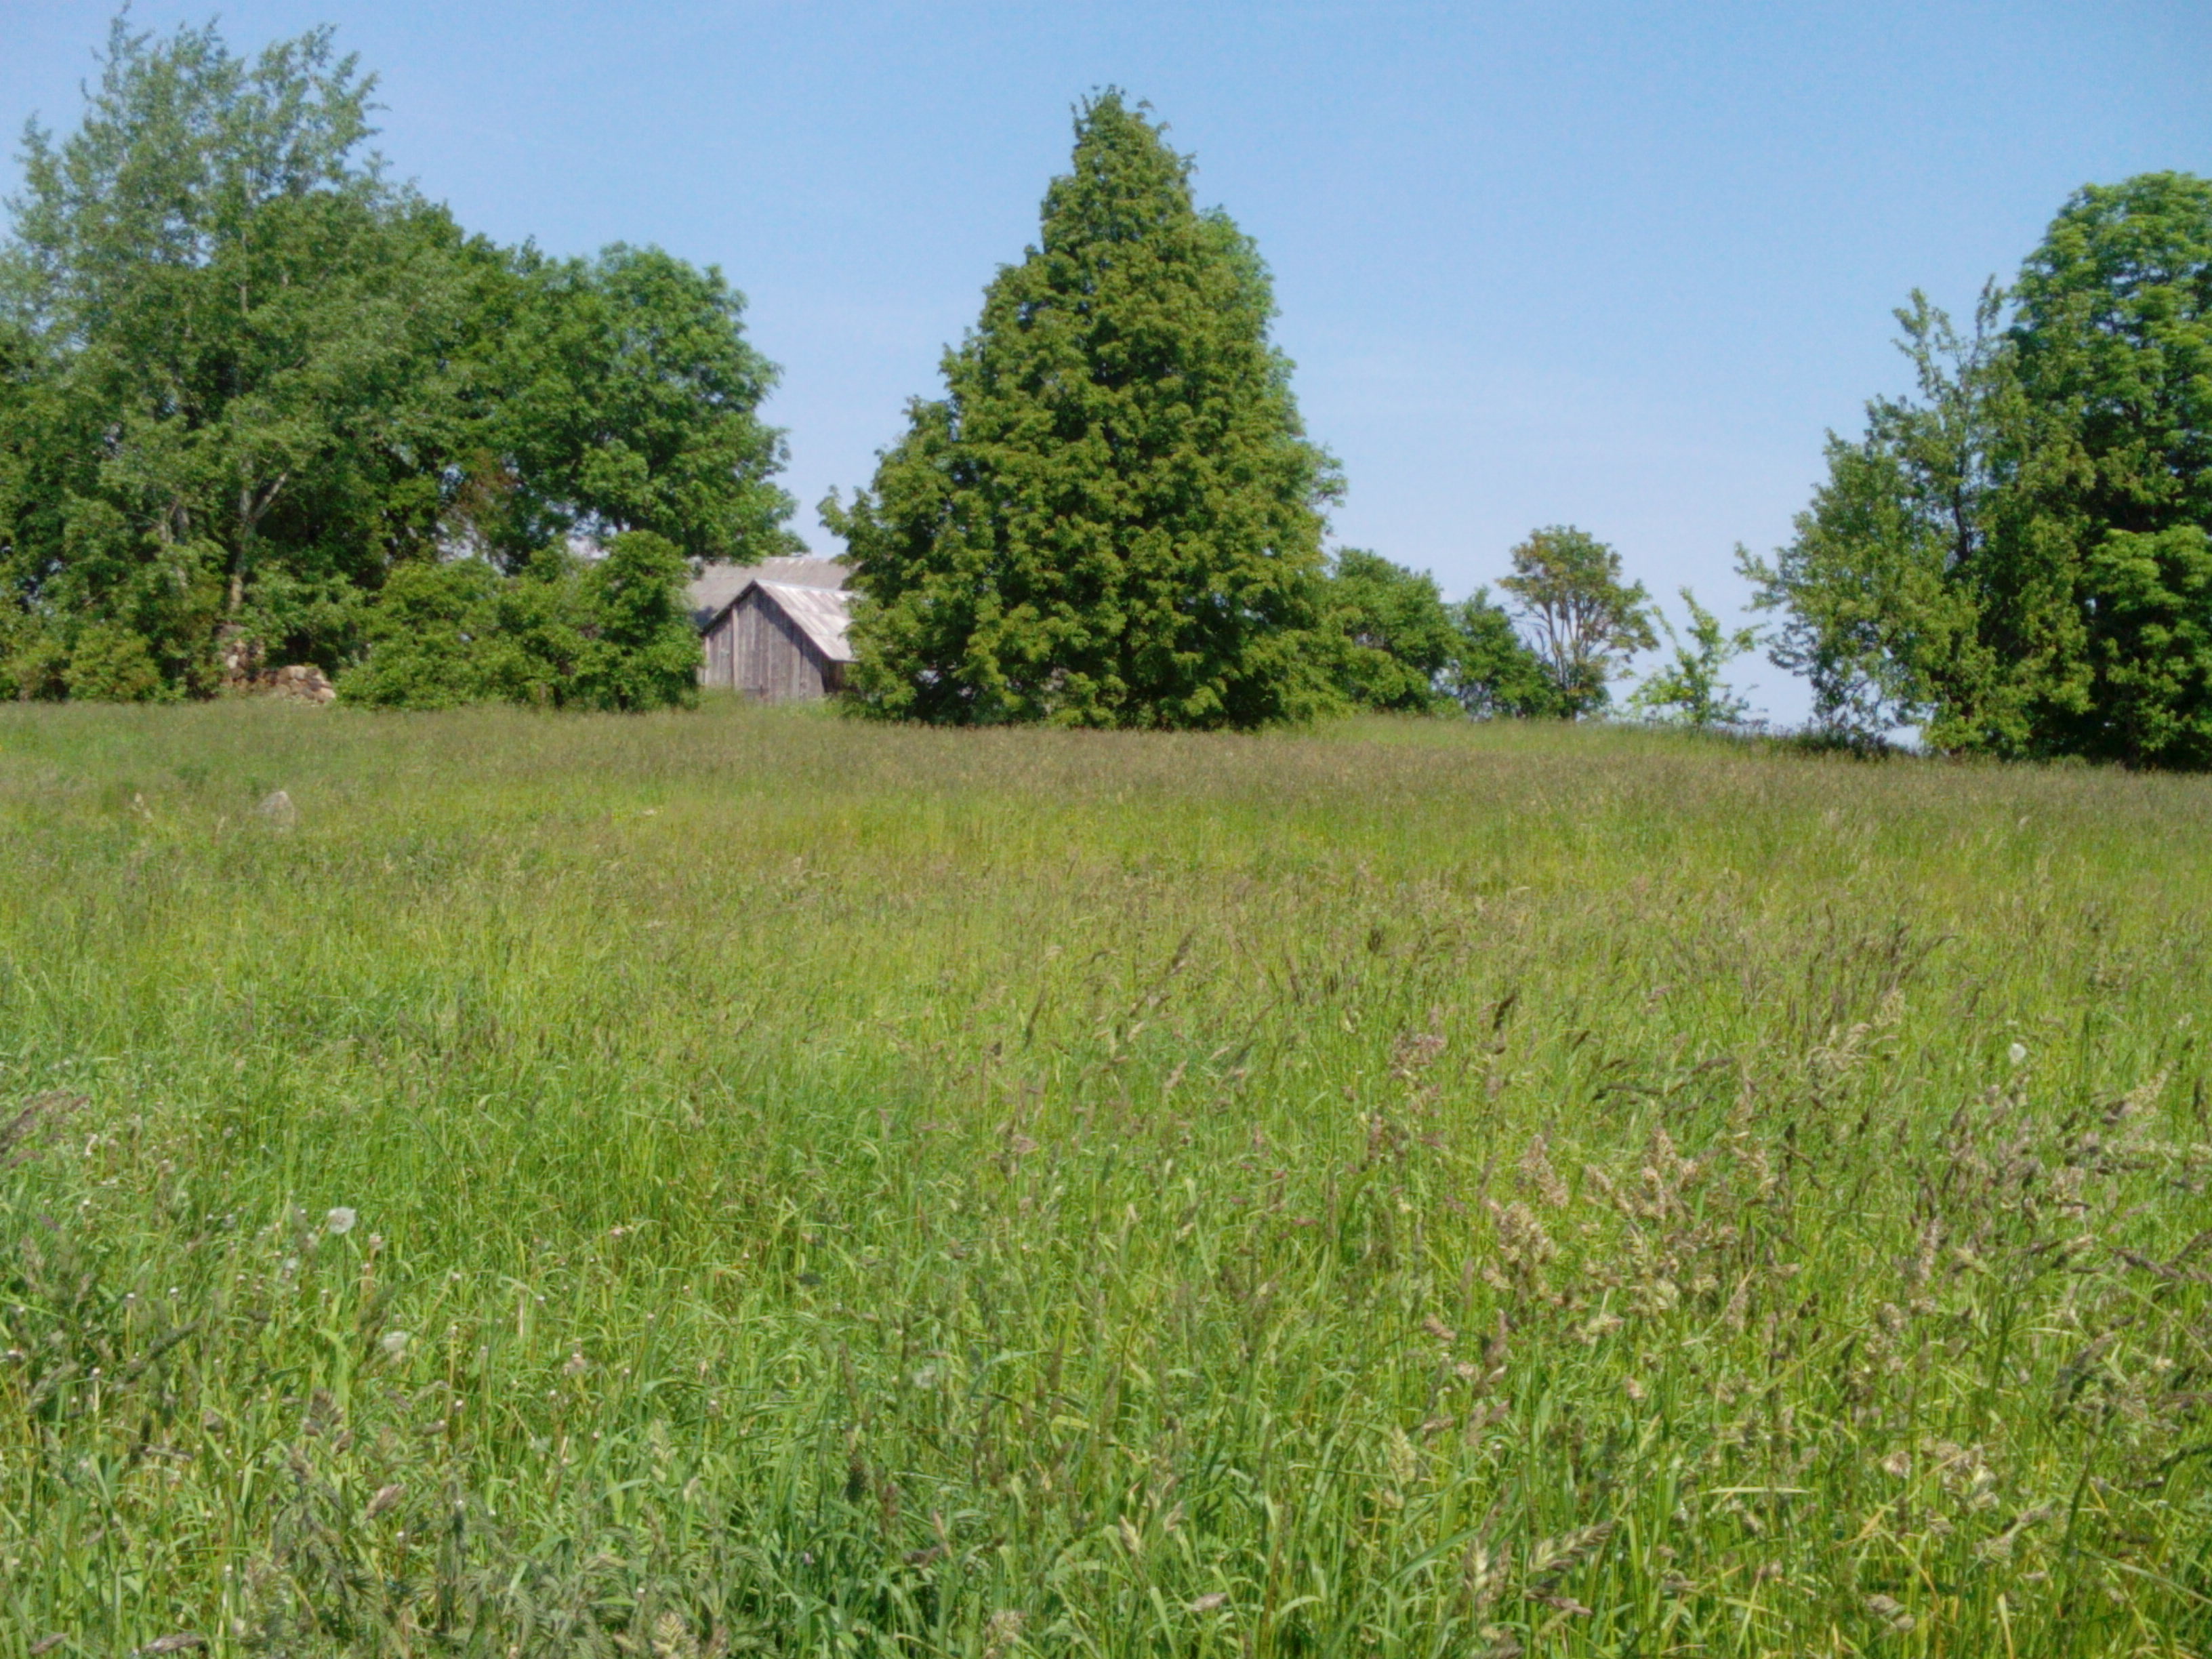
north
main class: Grassland
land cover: Grassland without tree/shrub cover
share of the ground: > 75 %
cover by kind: herbaceous plants 100 %
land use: Agriculture (excluding fallow land and kitchen gardens)
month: June
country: LV
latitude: 56.7970
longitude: 22.2836
